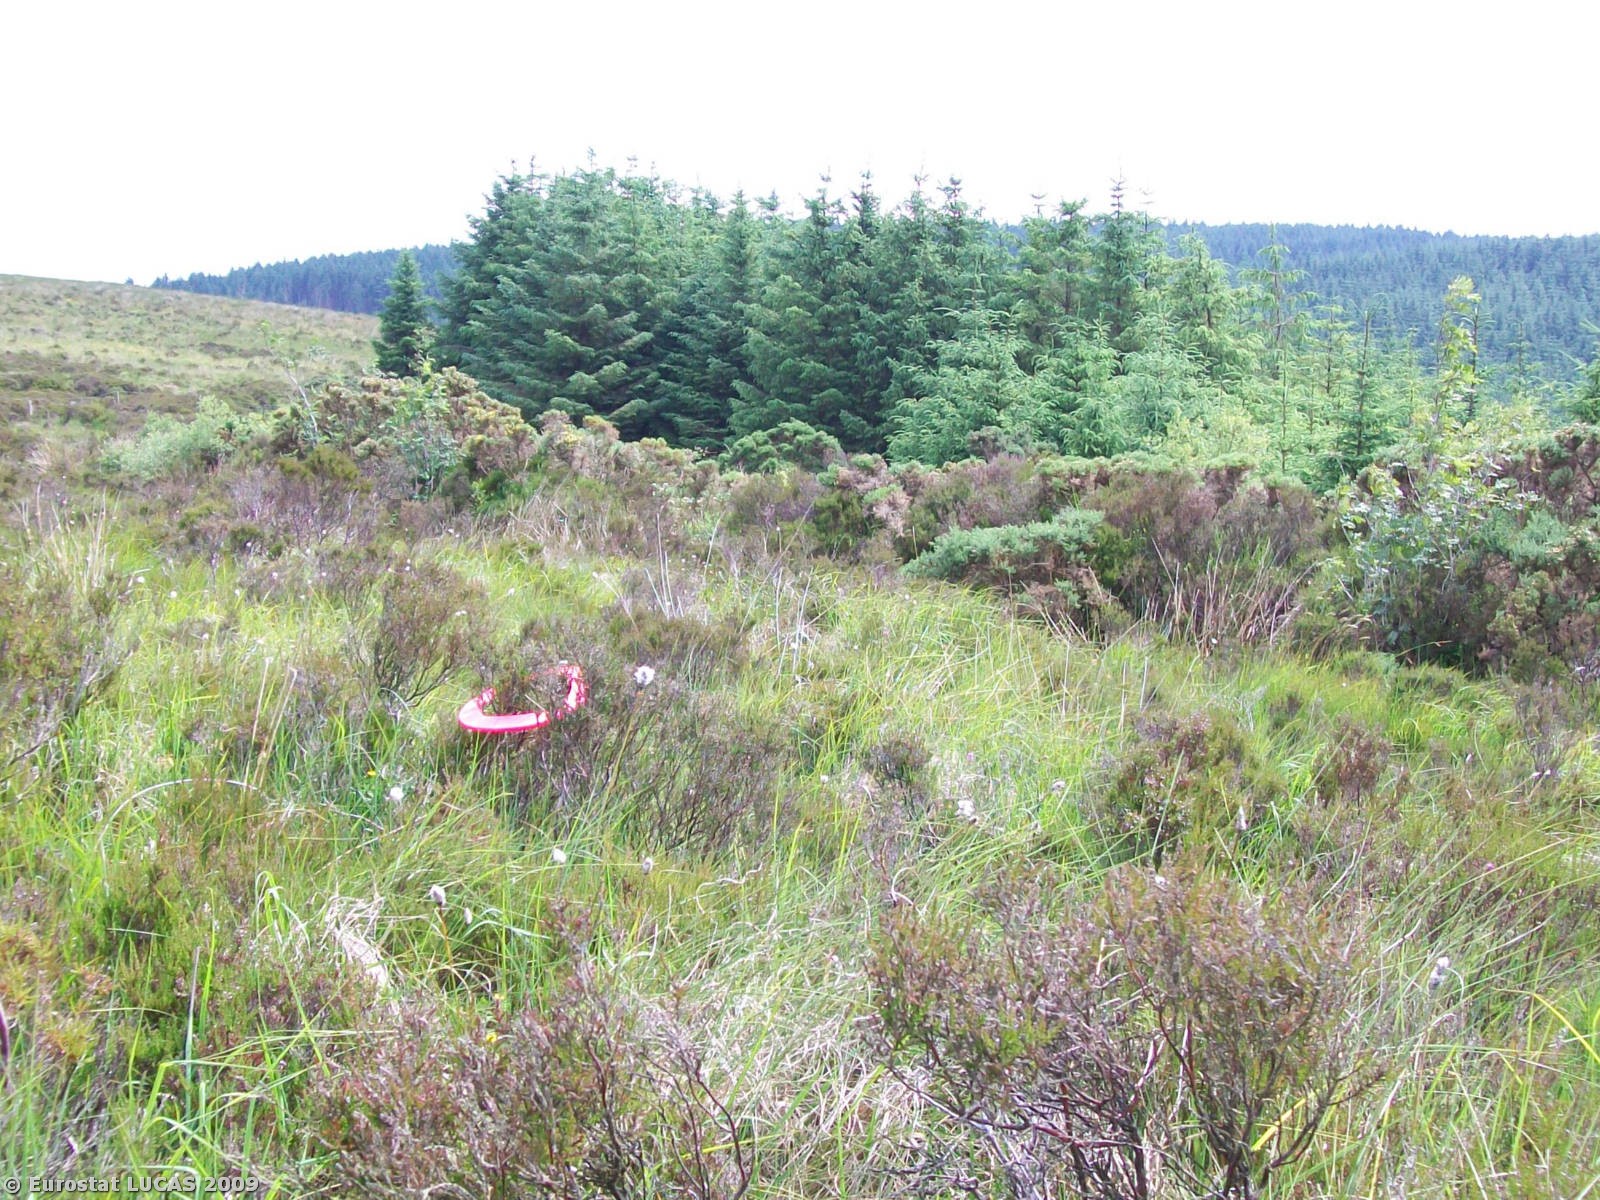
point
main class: Shrubland
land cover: Shrubland without tree cover
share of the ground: > 75 %
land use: Agriculture (excluding fallow land and kitchen gardens)
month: June
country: GB
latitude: 54.2874
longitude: -7.2456
